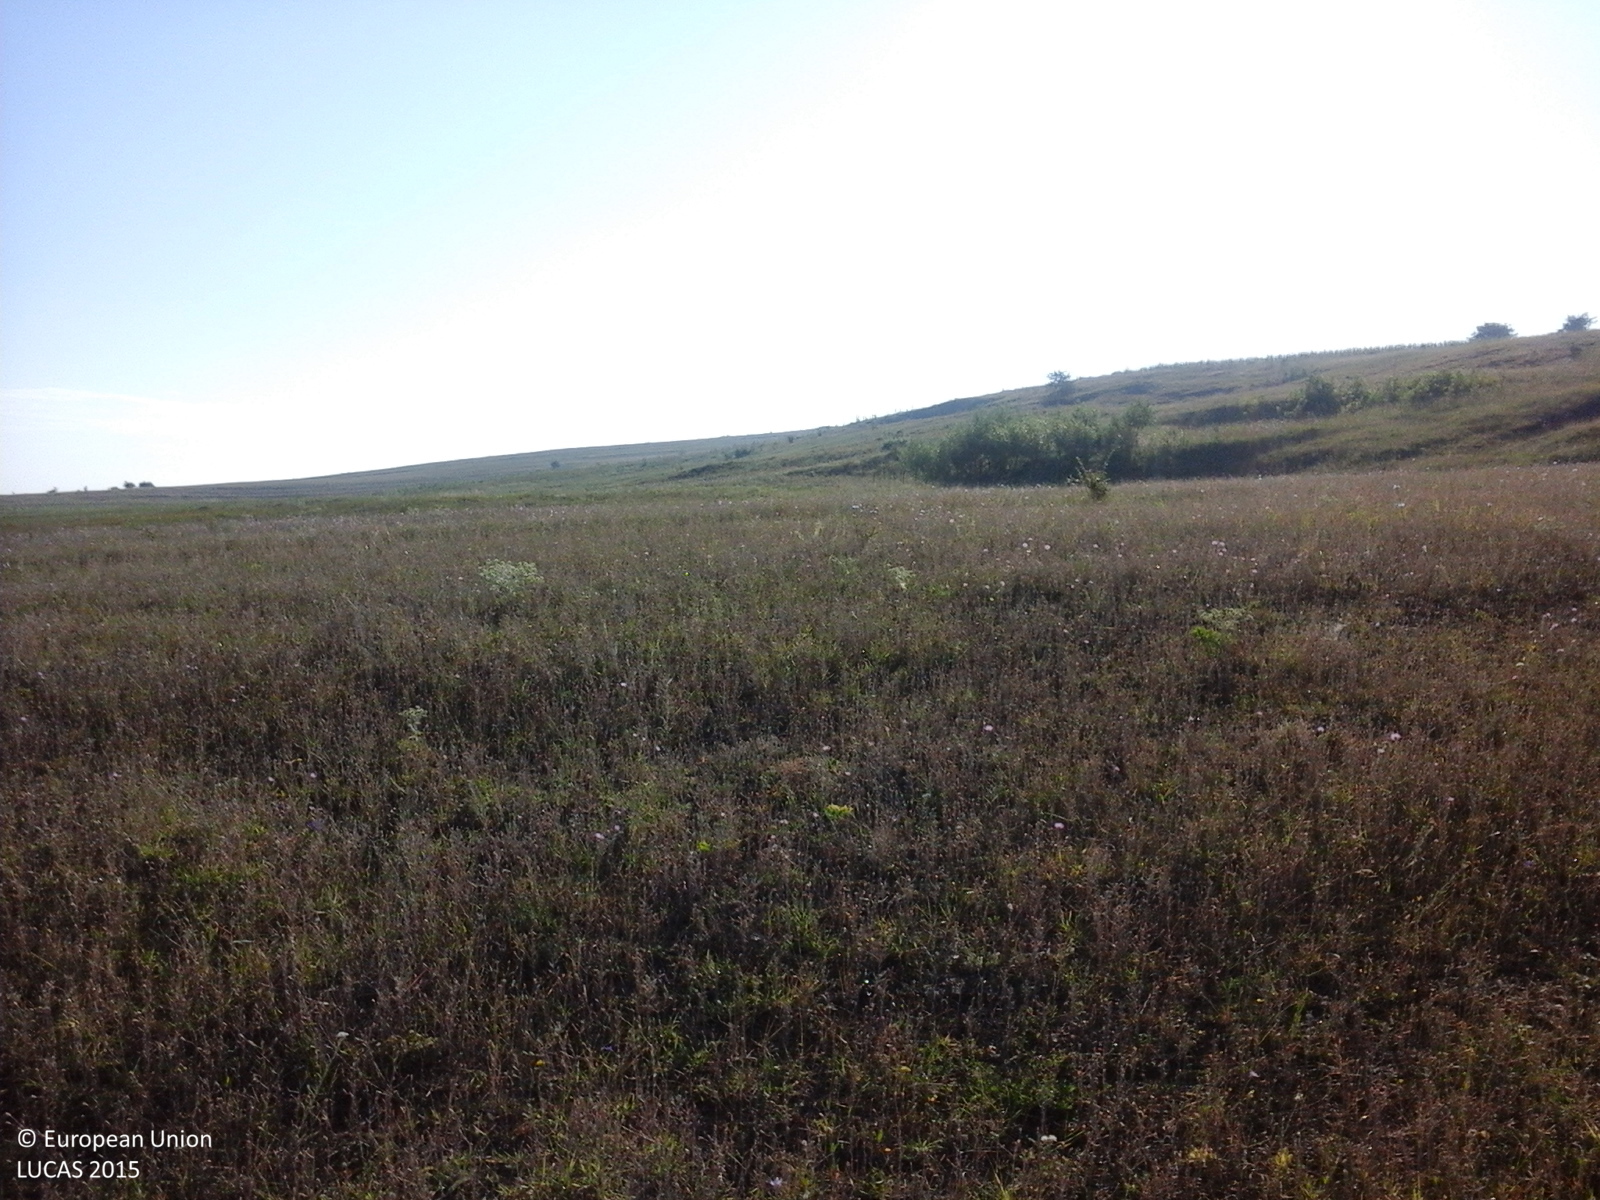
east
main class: Grassland
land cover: Grassland without tree/shrub cover
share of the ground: > 75 %
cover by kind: herbaceous plants 100 %
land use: Agriculture (excluding fallow land and kitchen gardens)
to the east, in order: Grassland without tree/shrub cover; Grassland with sparse tree/shrub cover; Grassland without tree/shrub cover; Maize
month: July
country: RO
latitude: 46.1959
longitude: 27.7522
